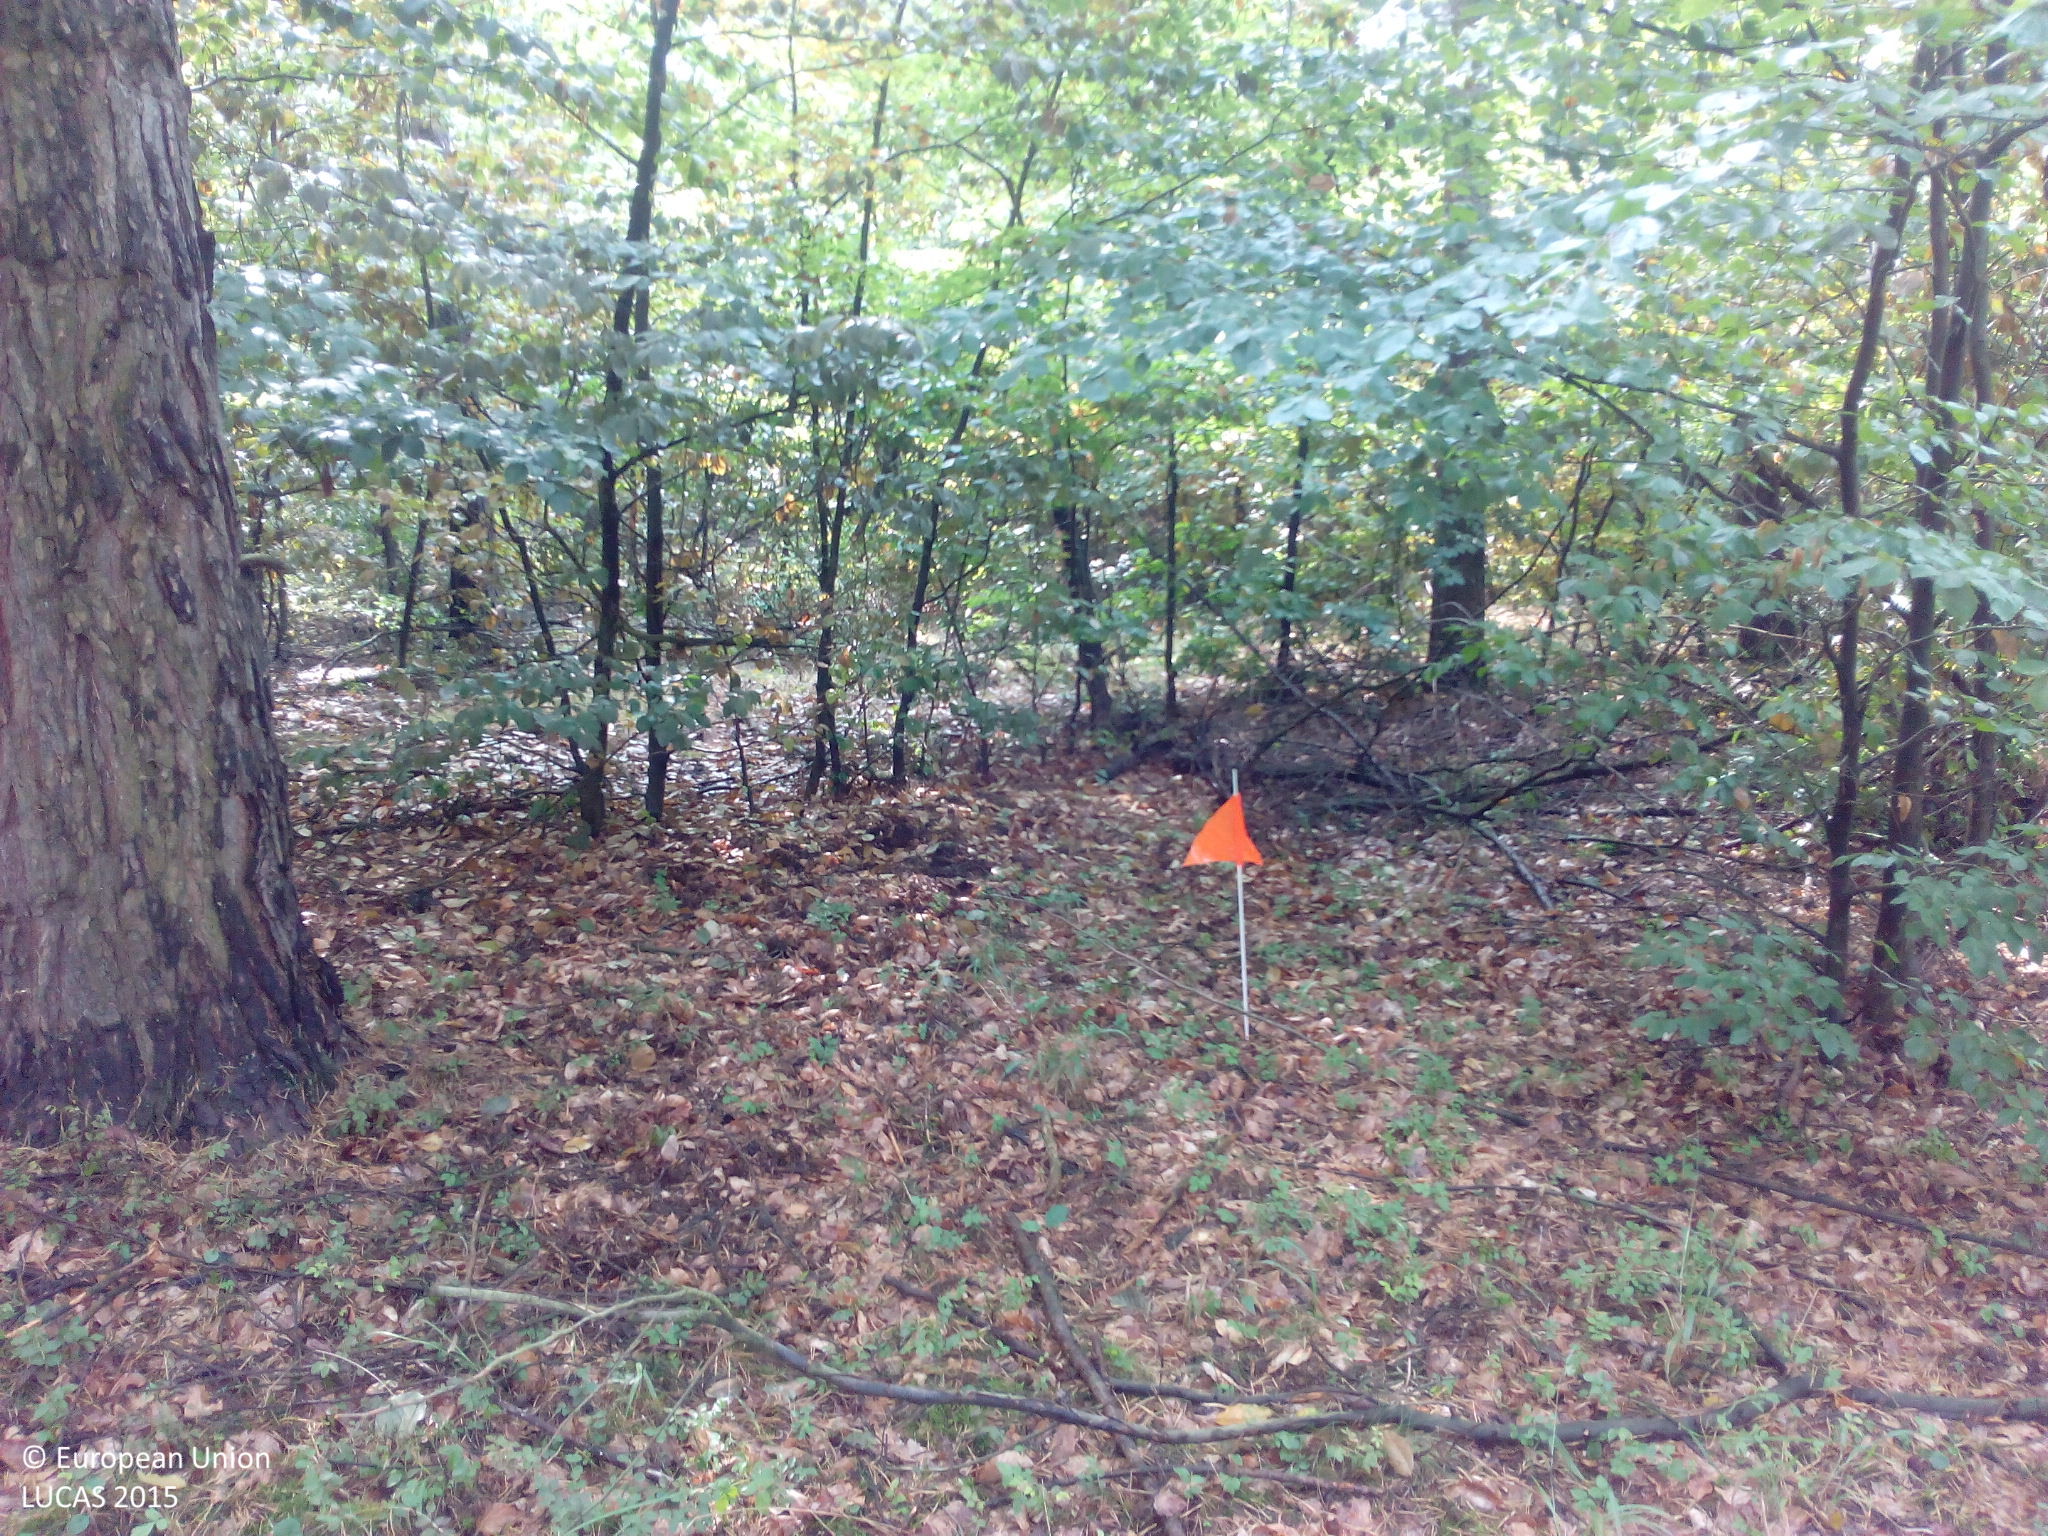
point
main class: Woodland
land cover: Other mixed woodland
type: hemiboreal forest and nemoral coniferous forest and mixed broadleaved-coniferous forest
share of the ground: > 75 %
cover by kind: coniferous forest trees 50 %, broadleaved forest trees 45 %, herbaceous plants 5 %
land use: Forestry
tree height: > 5 m
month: August
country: DE
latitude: 51.6665
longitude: 12.5589
